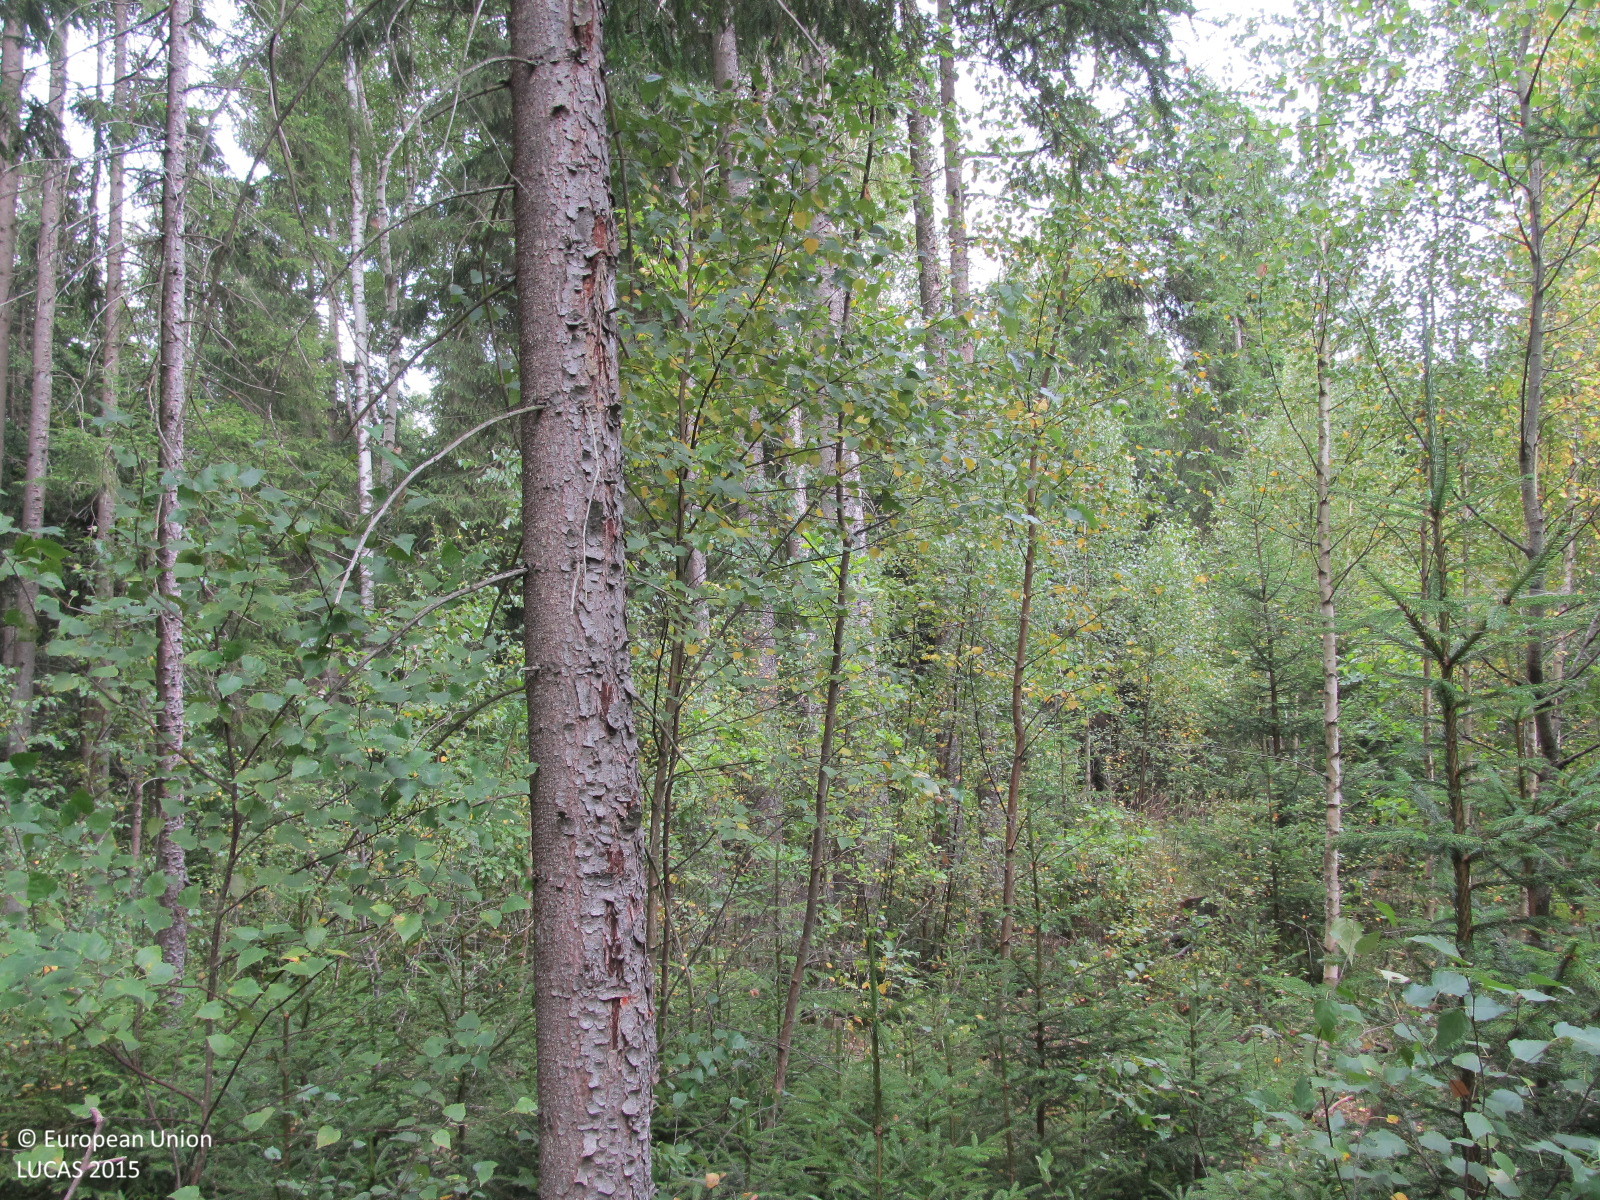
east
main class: Woodland
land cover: Spruce dominated mixed woodland
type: hemiboreal forest and nemoral coniferous forest and mixed broadleaved-coniferous forest
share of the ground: > 75 %
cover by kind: coniferous forest trees 50 %, broadleaved forest trees 30 %, shrubs 10 %, herbaceous plants 5 %, lichens and mosses 5 %
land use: Forestry
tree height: > 5 m
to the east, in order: Spruce dominated mixed woodland; Spruce dominated coniferous woodland
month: August
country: LT
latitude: 55.6516
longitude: 22.9890
